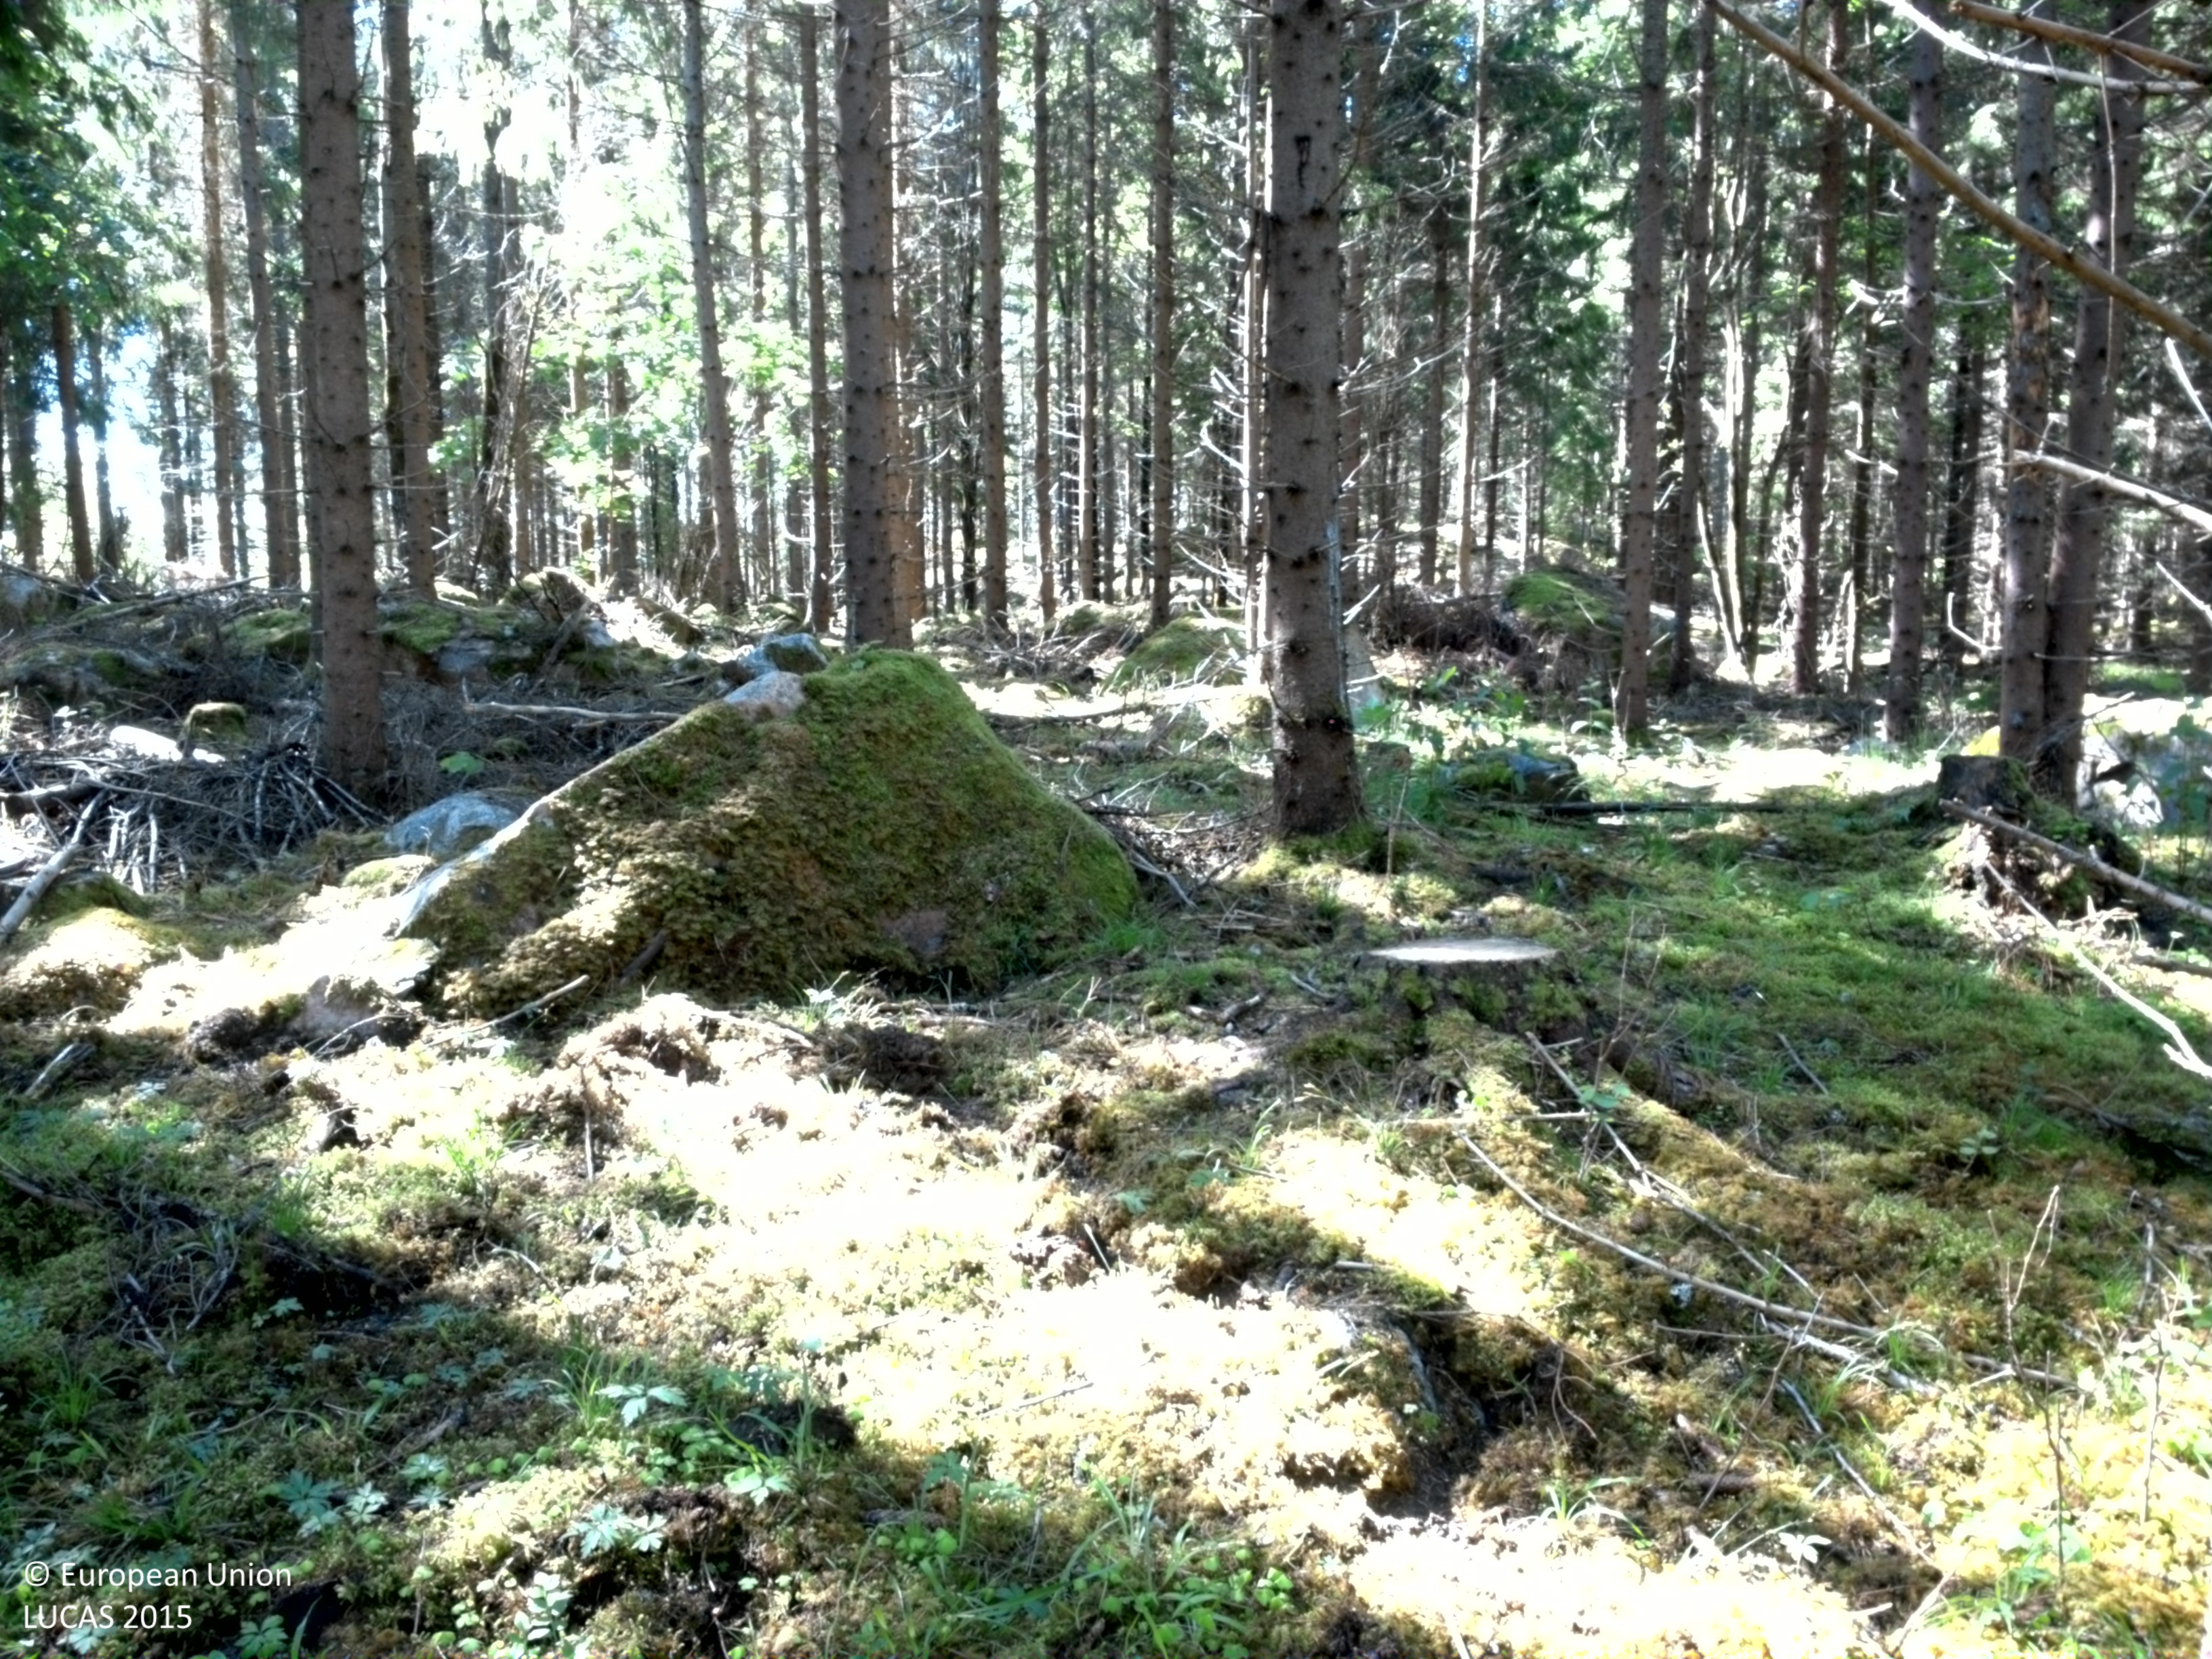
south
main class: Woodland
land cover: Spruce dominated coniferous woodland
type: boreal forest
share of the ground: 50 - 75 %
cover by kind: coniferous forest trees 75 %, herbaceous plants 15 %, lichens and mosses 10 %
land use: Forestry
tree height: > 5 m
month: June
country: SE
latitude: 59.9809
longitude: 17.5017
